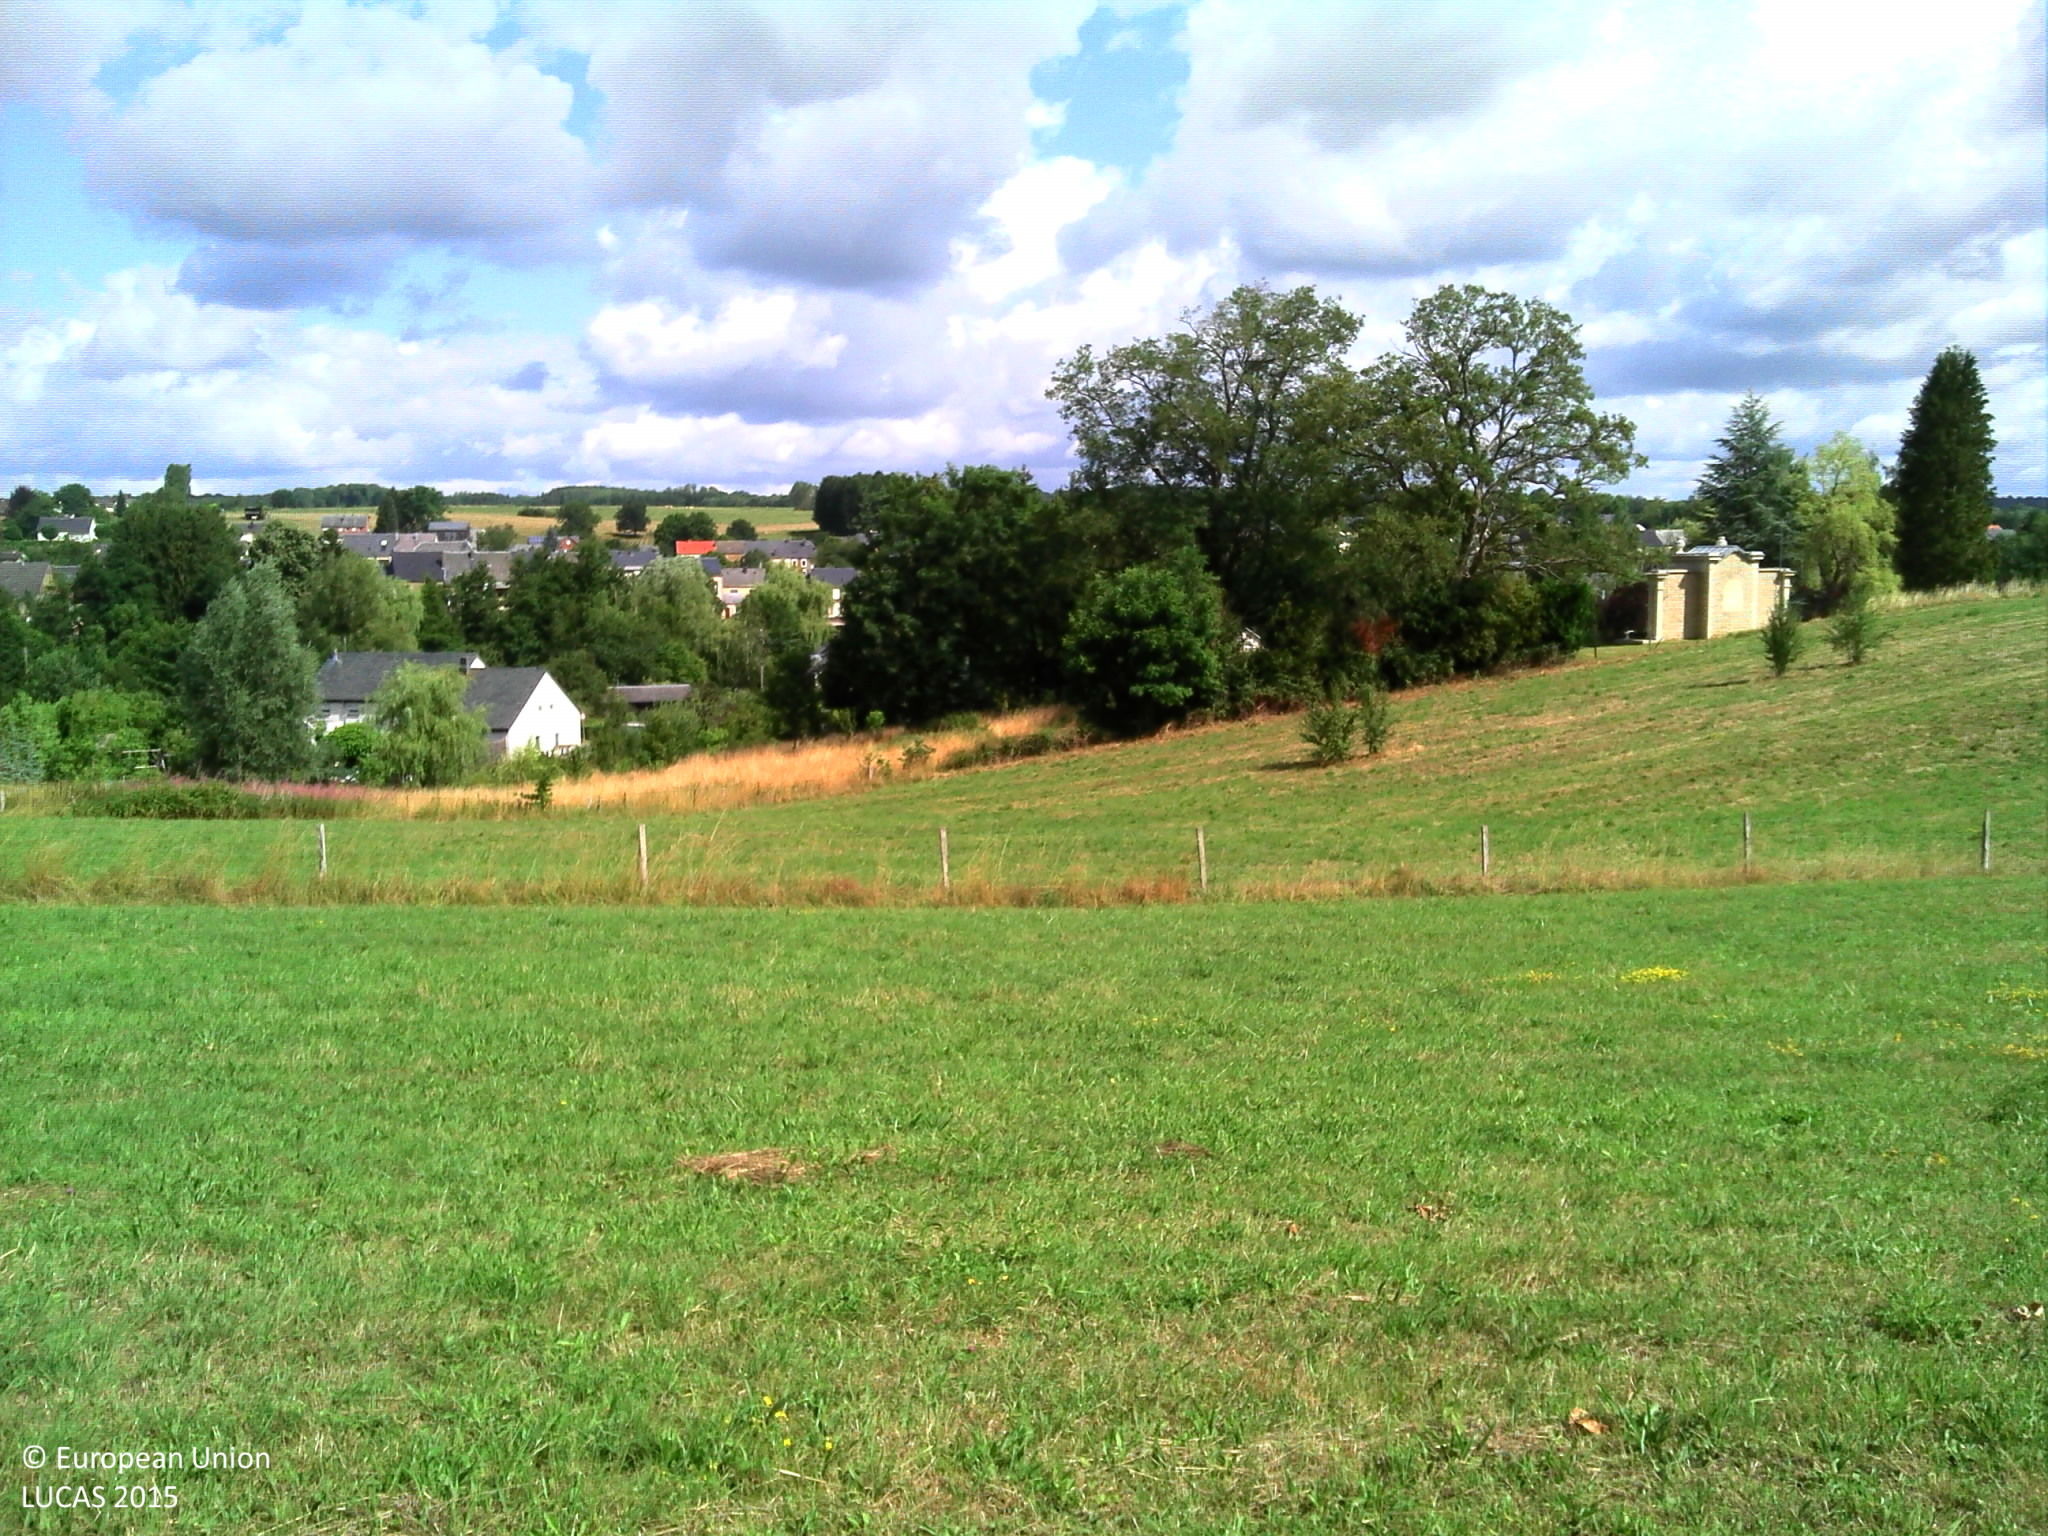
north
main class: Grassland
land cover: Grassland without tree/shrub cover
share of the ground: > 75 %
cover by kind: herbaceous plants 100 %
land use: Agriculture (excluding fallow land and kitchen gardens)
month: July
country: BE
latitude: 49.5765
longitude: 5.5870
